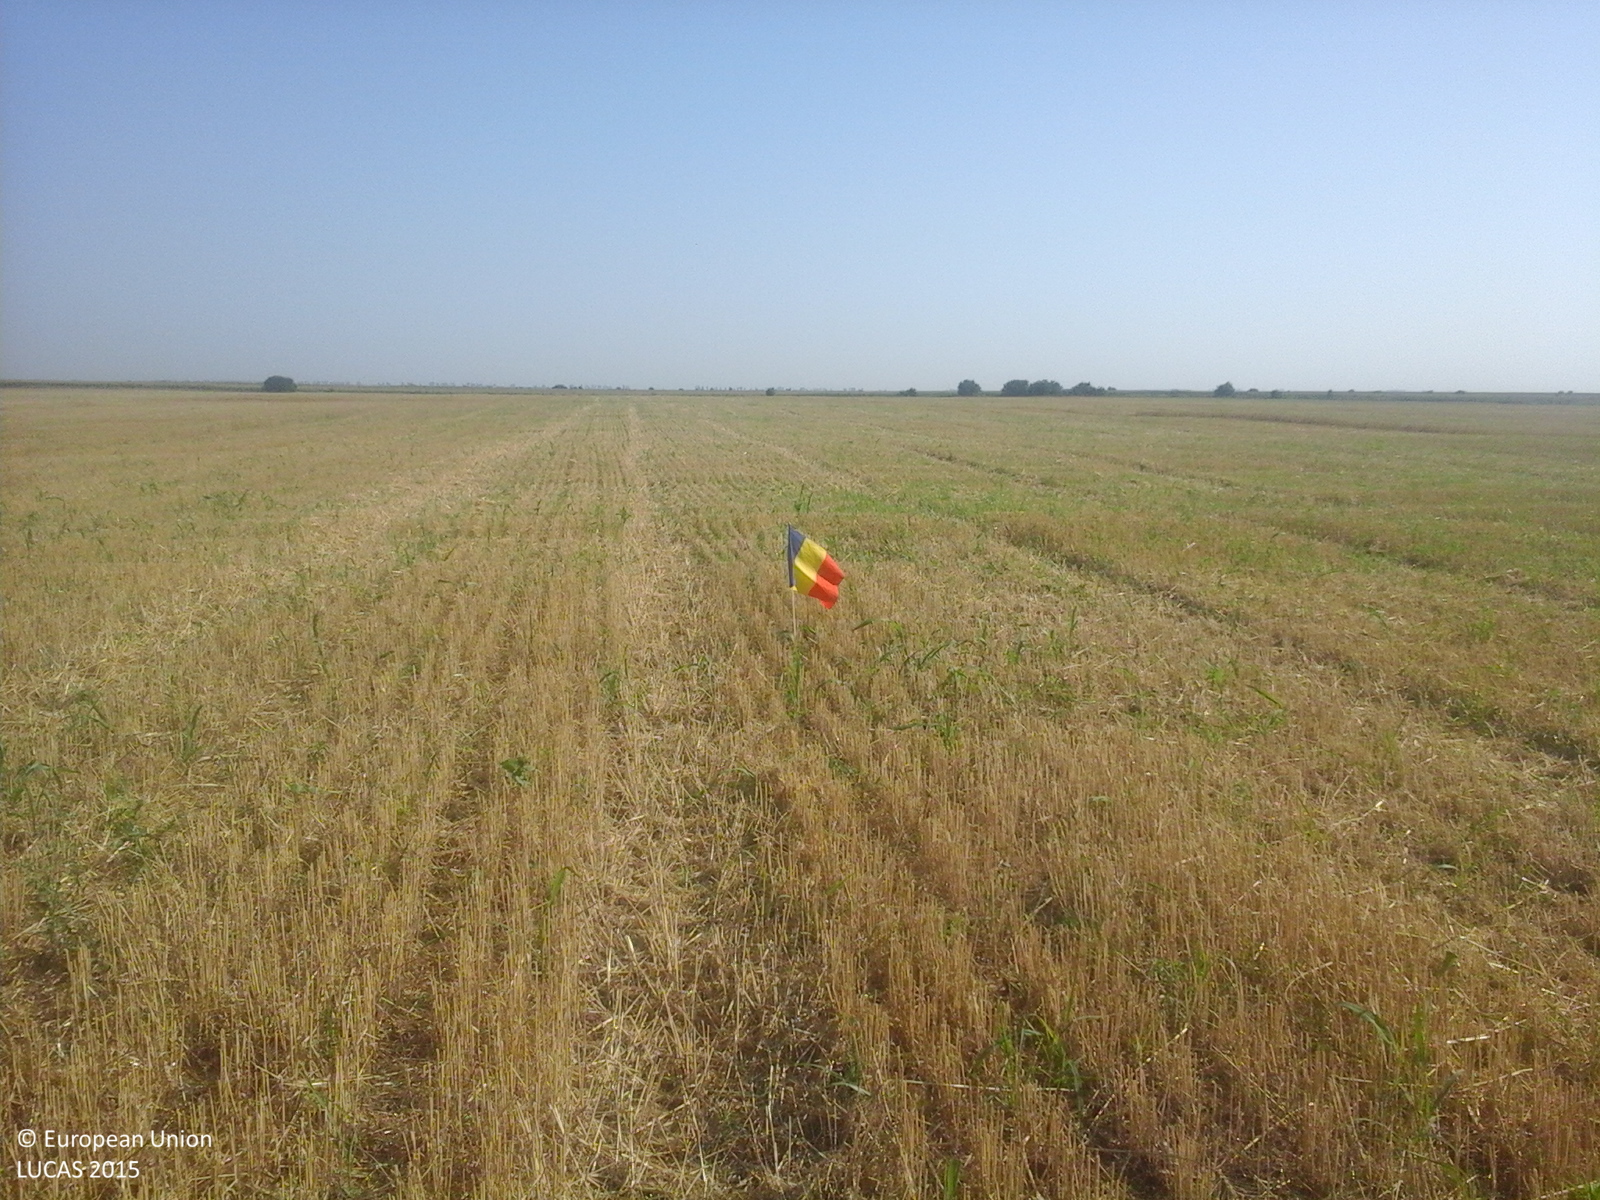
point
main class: Cropland
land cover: Common wheat
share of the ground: 10 - 25 %
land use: Agriculture (excluding fallow land and kitchen gardens)
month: July
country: RO
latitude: 44.3500
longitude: 27.2323
